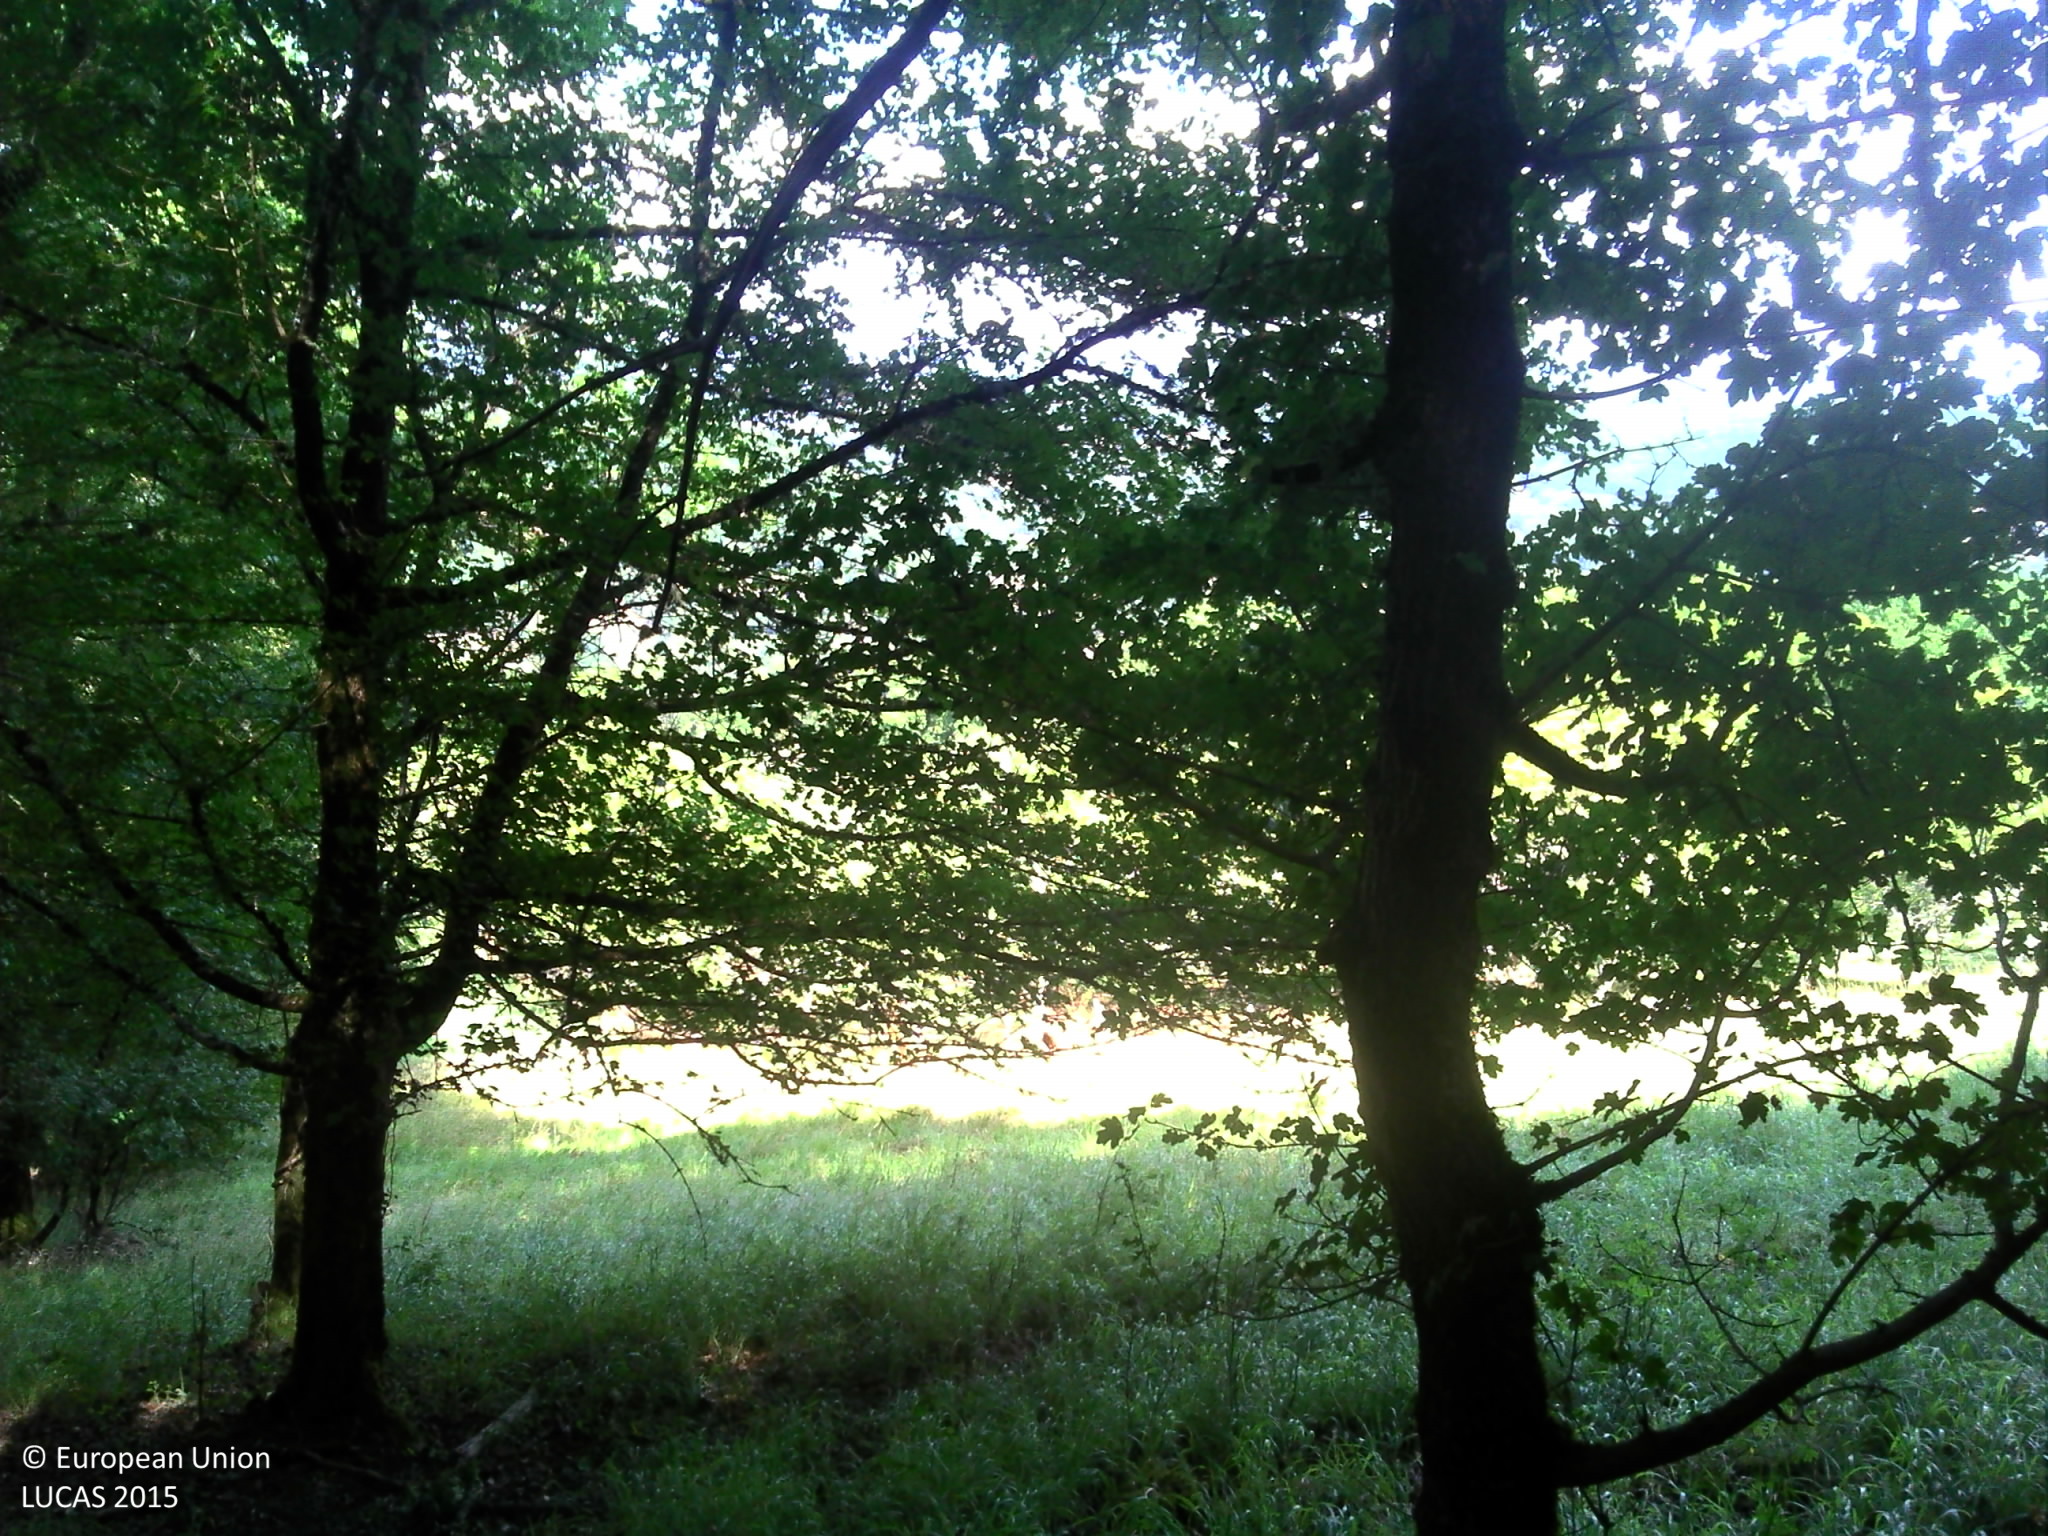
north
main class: Woodland
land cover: Broadleaved woodland
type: thermophilous deciduous forest
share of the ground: > 75 %
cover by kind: broadleaved forest trees 90 %, herbaceous plants 5 %, lichens and mosses 5 %
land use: Forestry
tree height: > 5 m
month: August
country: FR
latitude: 44.8618
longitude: 1.8354
